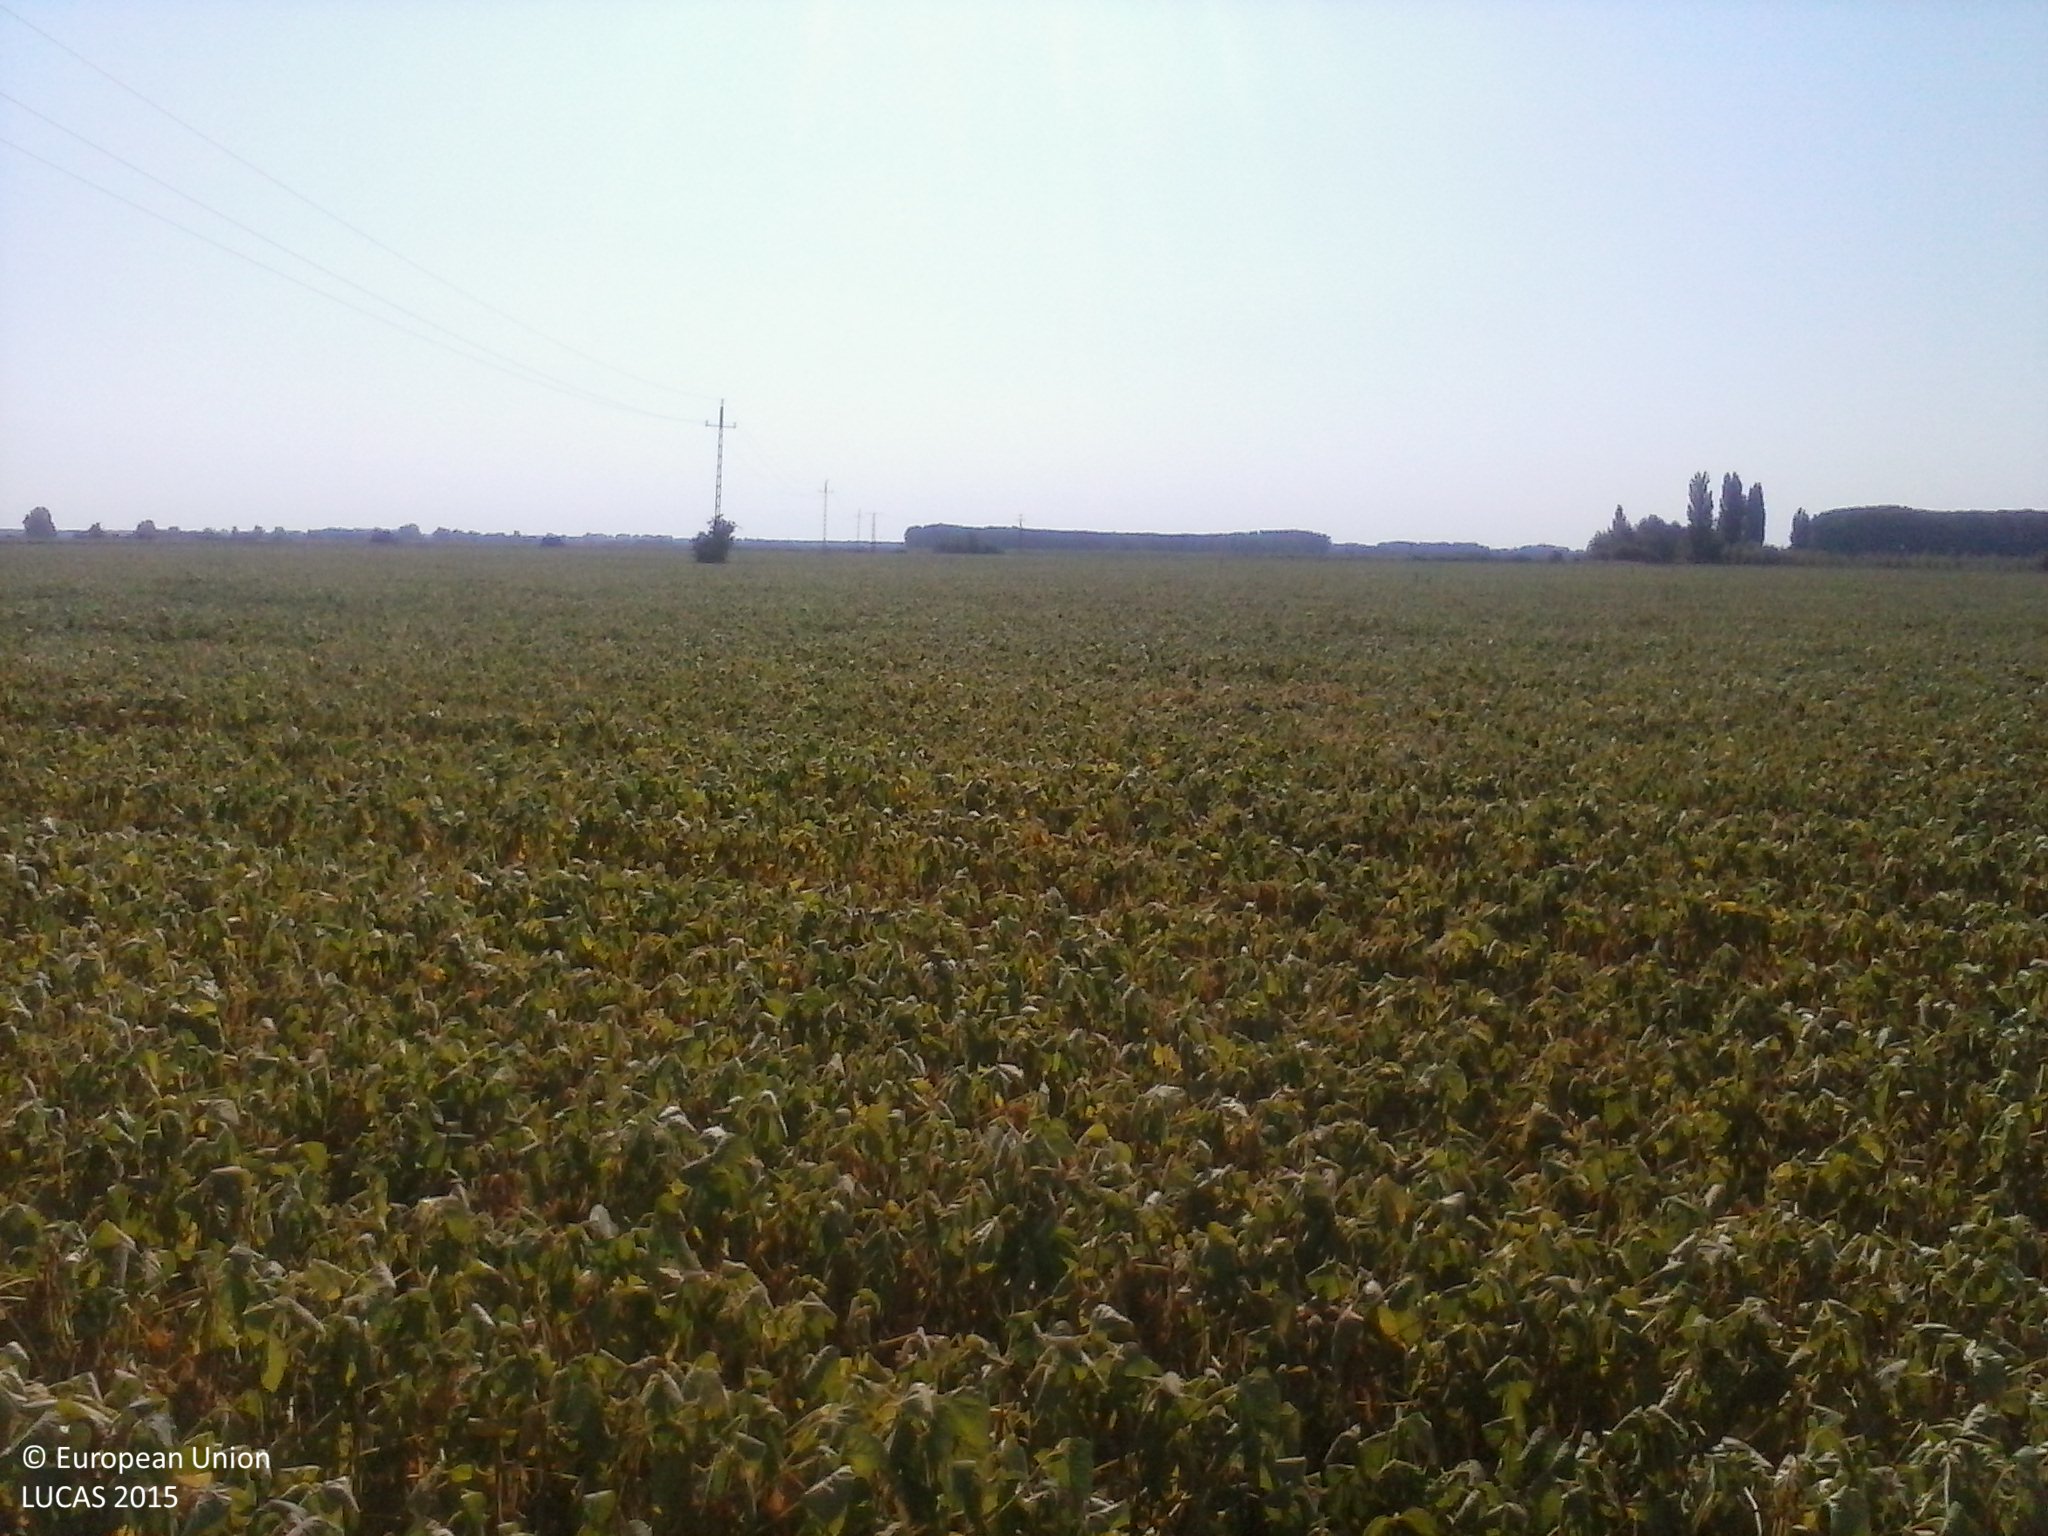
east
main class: Cropland
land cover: Soya
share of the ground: > 75 %
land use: Agriculture (excluding fallow land and kitchen gardens)
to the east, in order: Soya; Electric lines; Soya
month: July
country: HU
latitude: 46.0193
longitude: 18.8588
